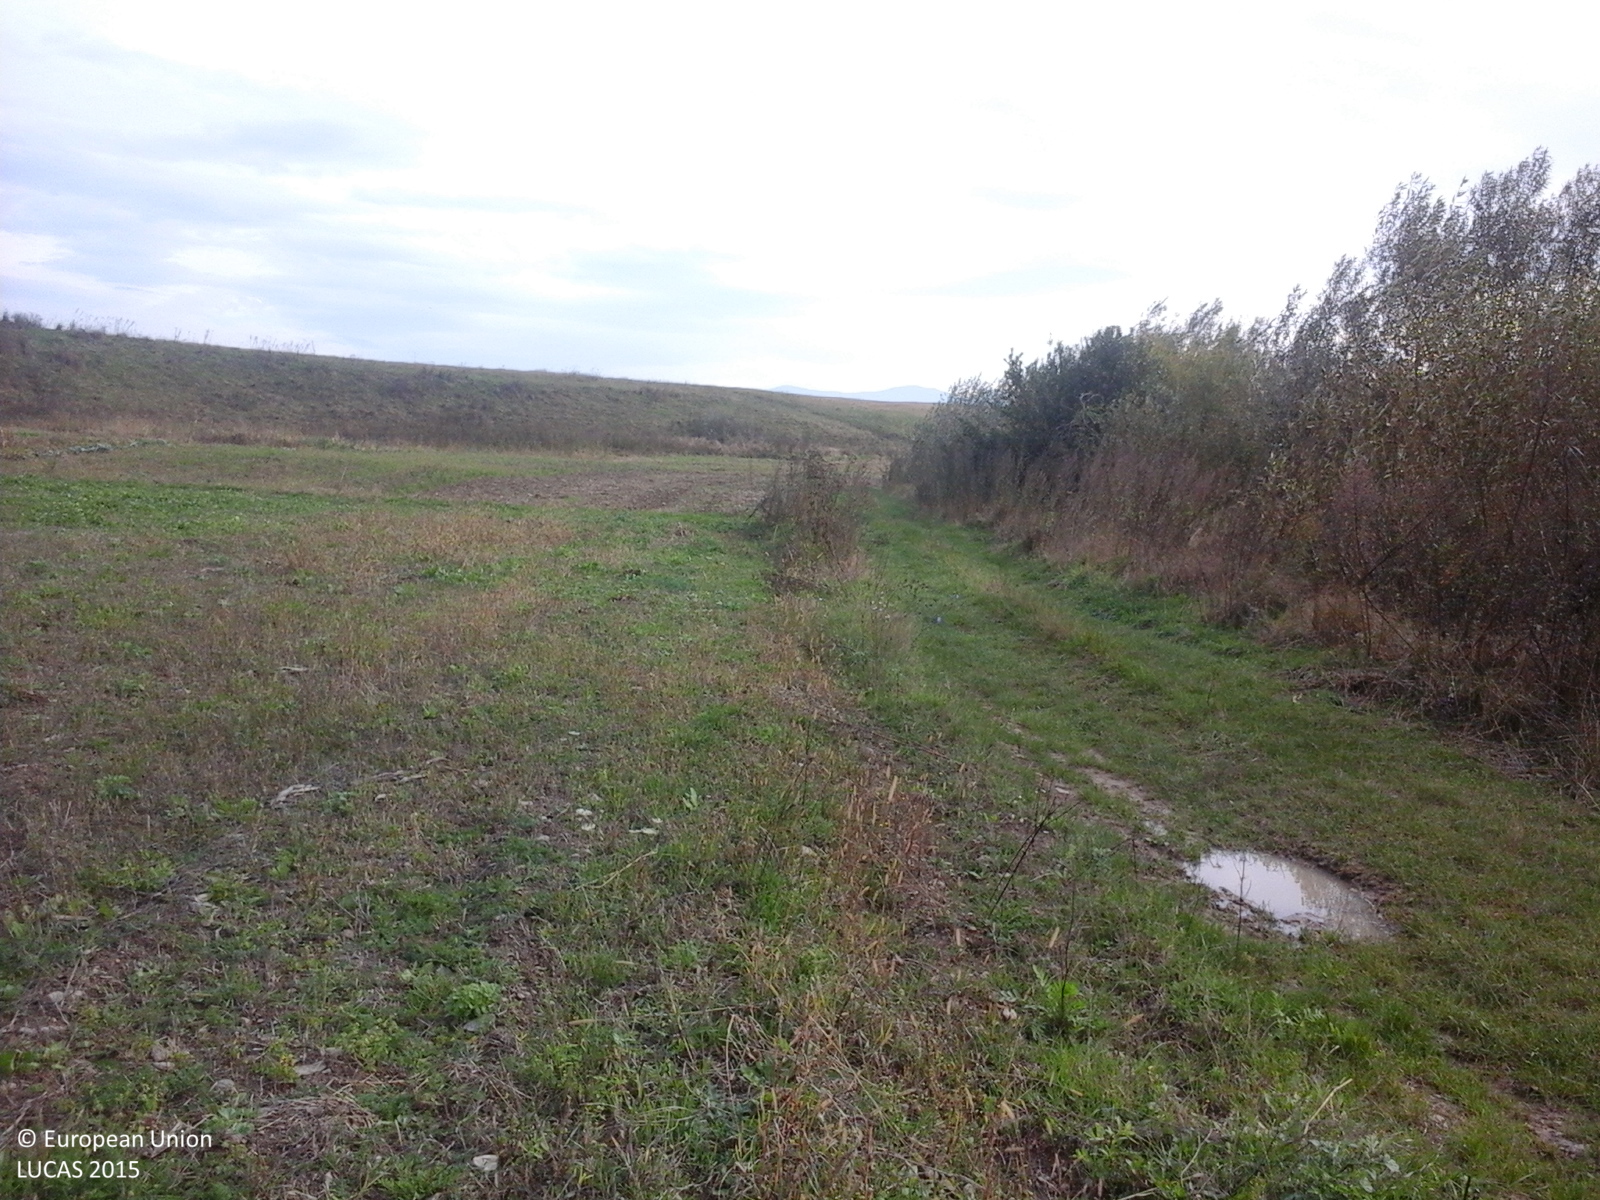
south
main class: Grassland
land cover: Grassland without tree/shrub cover
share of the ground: > 75 %
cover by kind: herbaceous plants 100 %
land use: Agriculture (excluding fallow land and kitchen gardens)
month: October
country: RO
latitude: 45.7908
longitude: 25.0542
